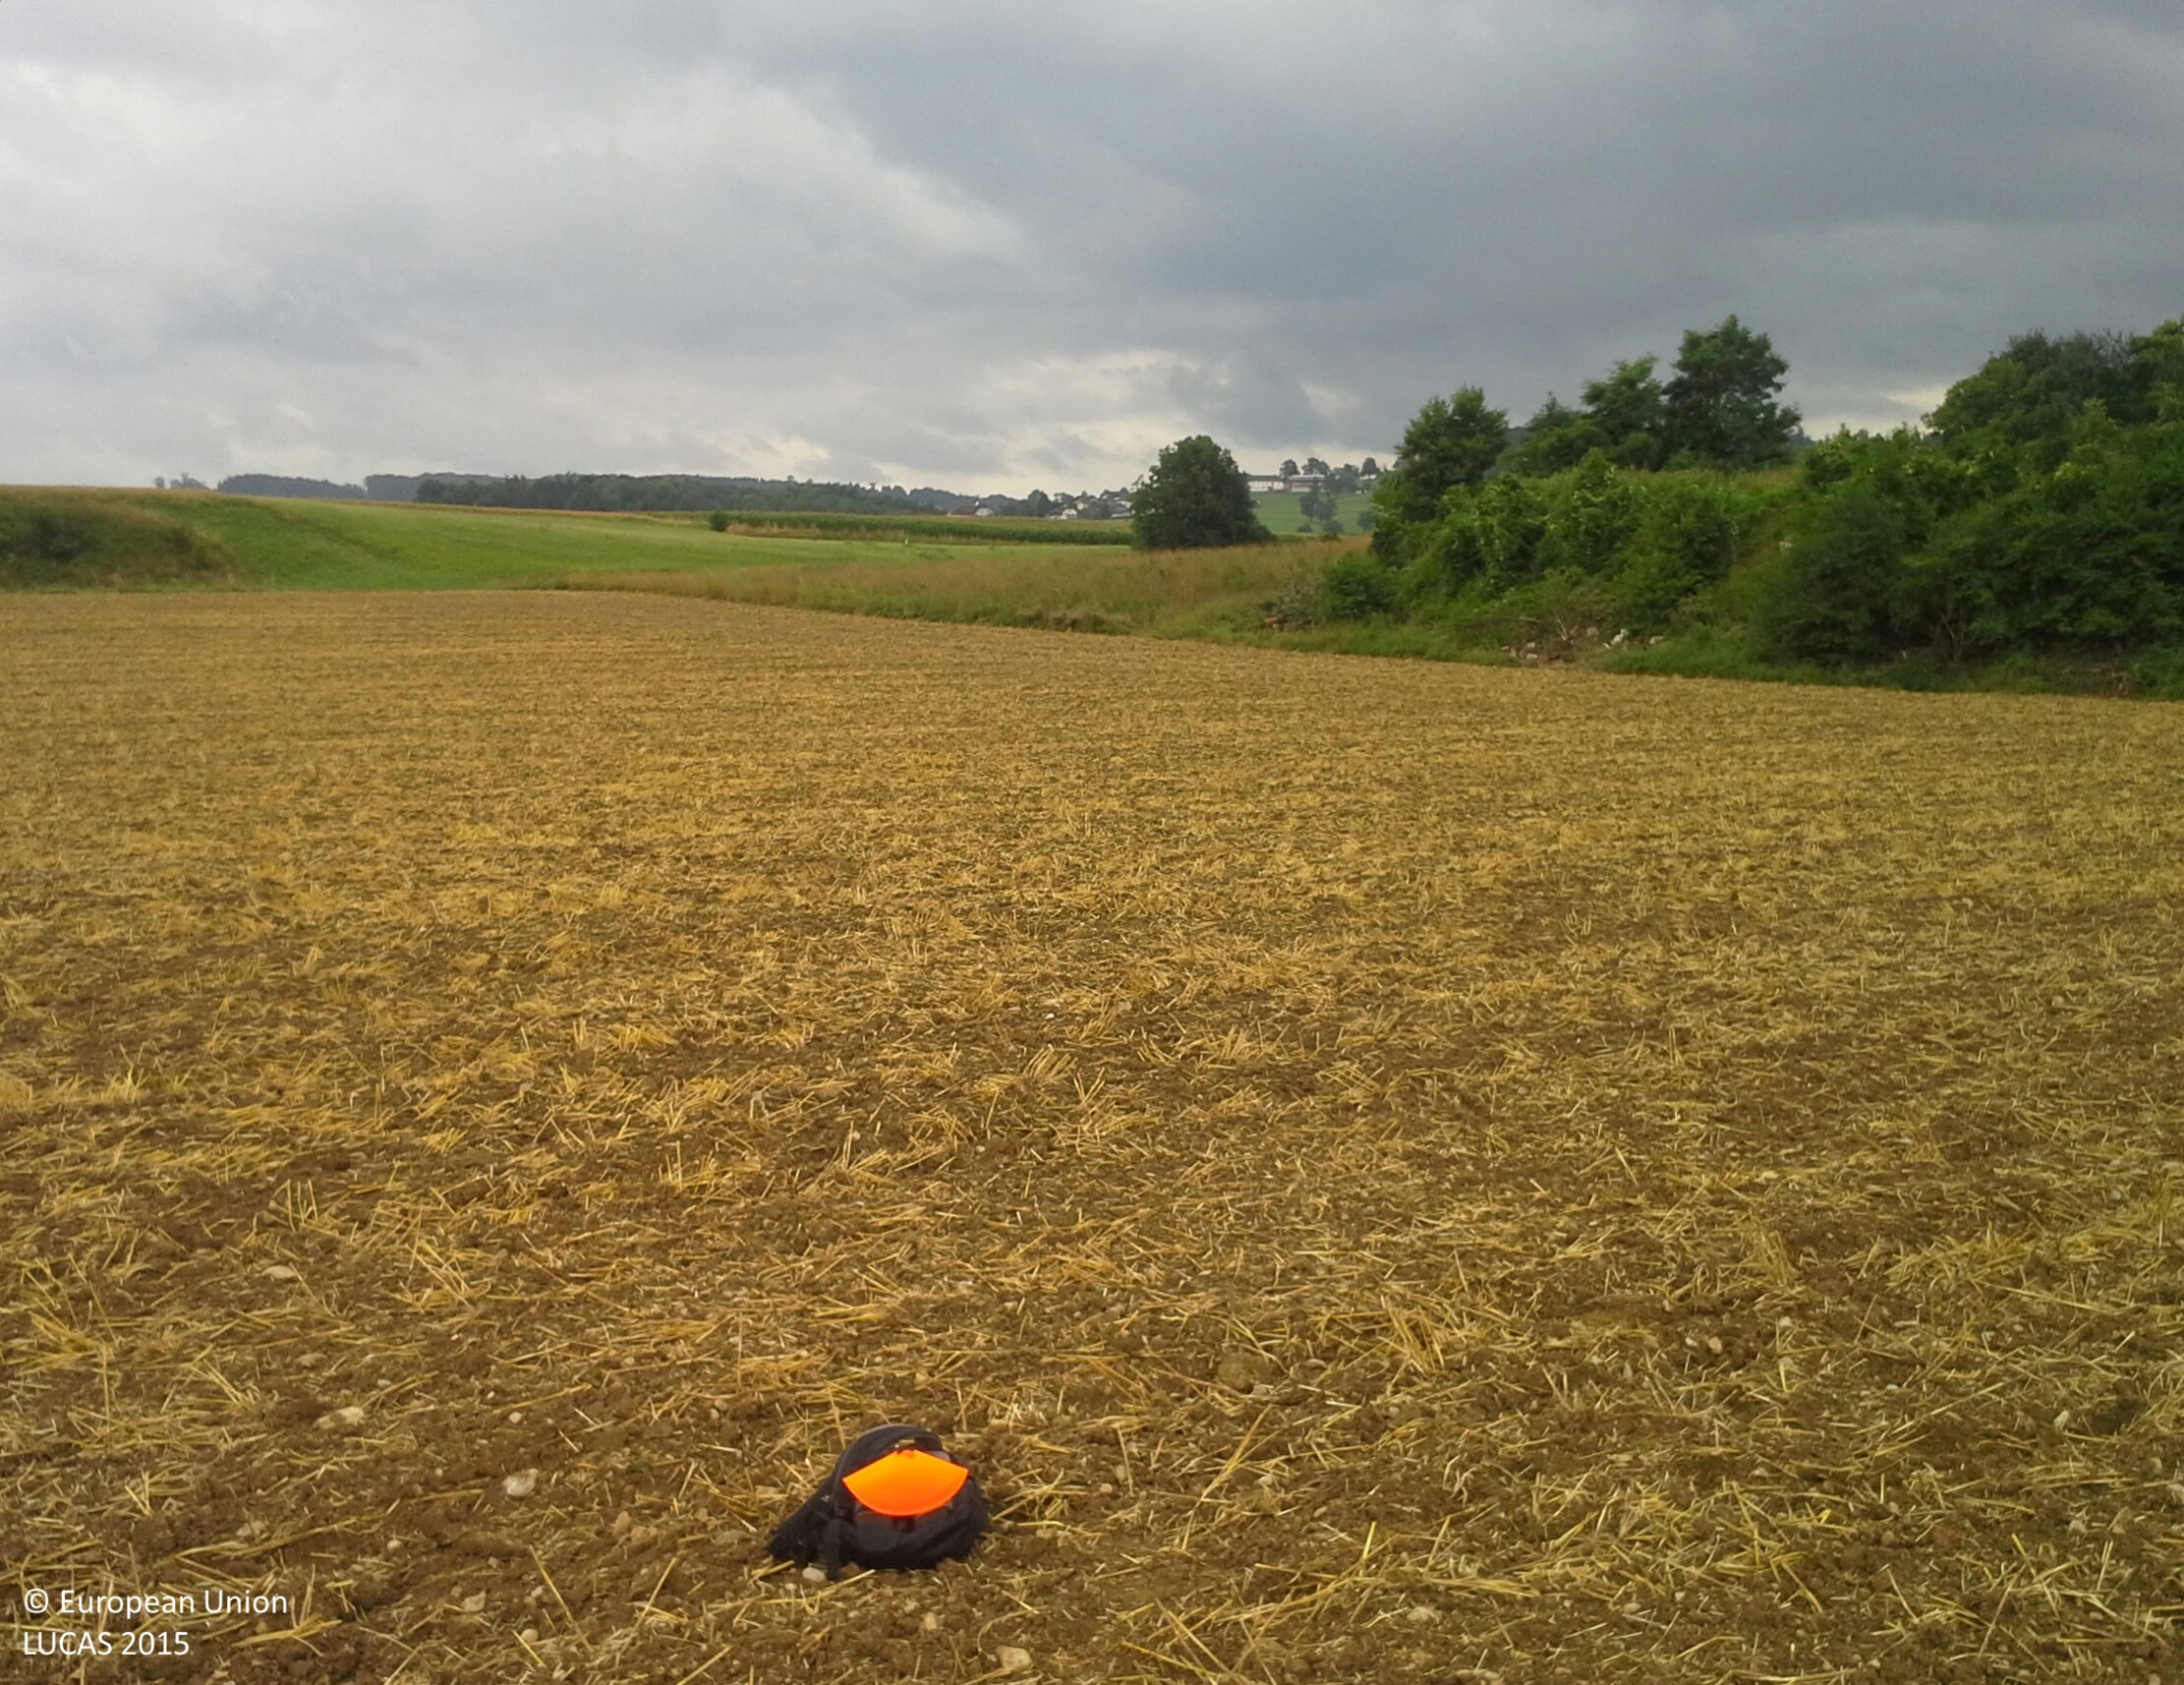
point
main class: Cropland
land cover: Barley
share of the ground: 10 - 25 %
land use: Agriculture (excluding fallow land and kitchen gardens)
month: July
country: AT
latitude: 48.0630
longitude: 14.8449
